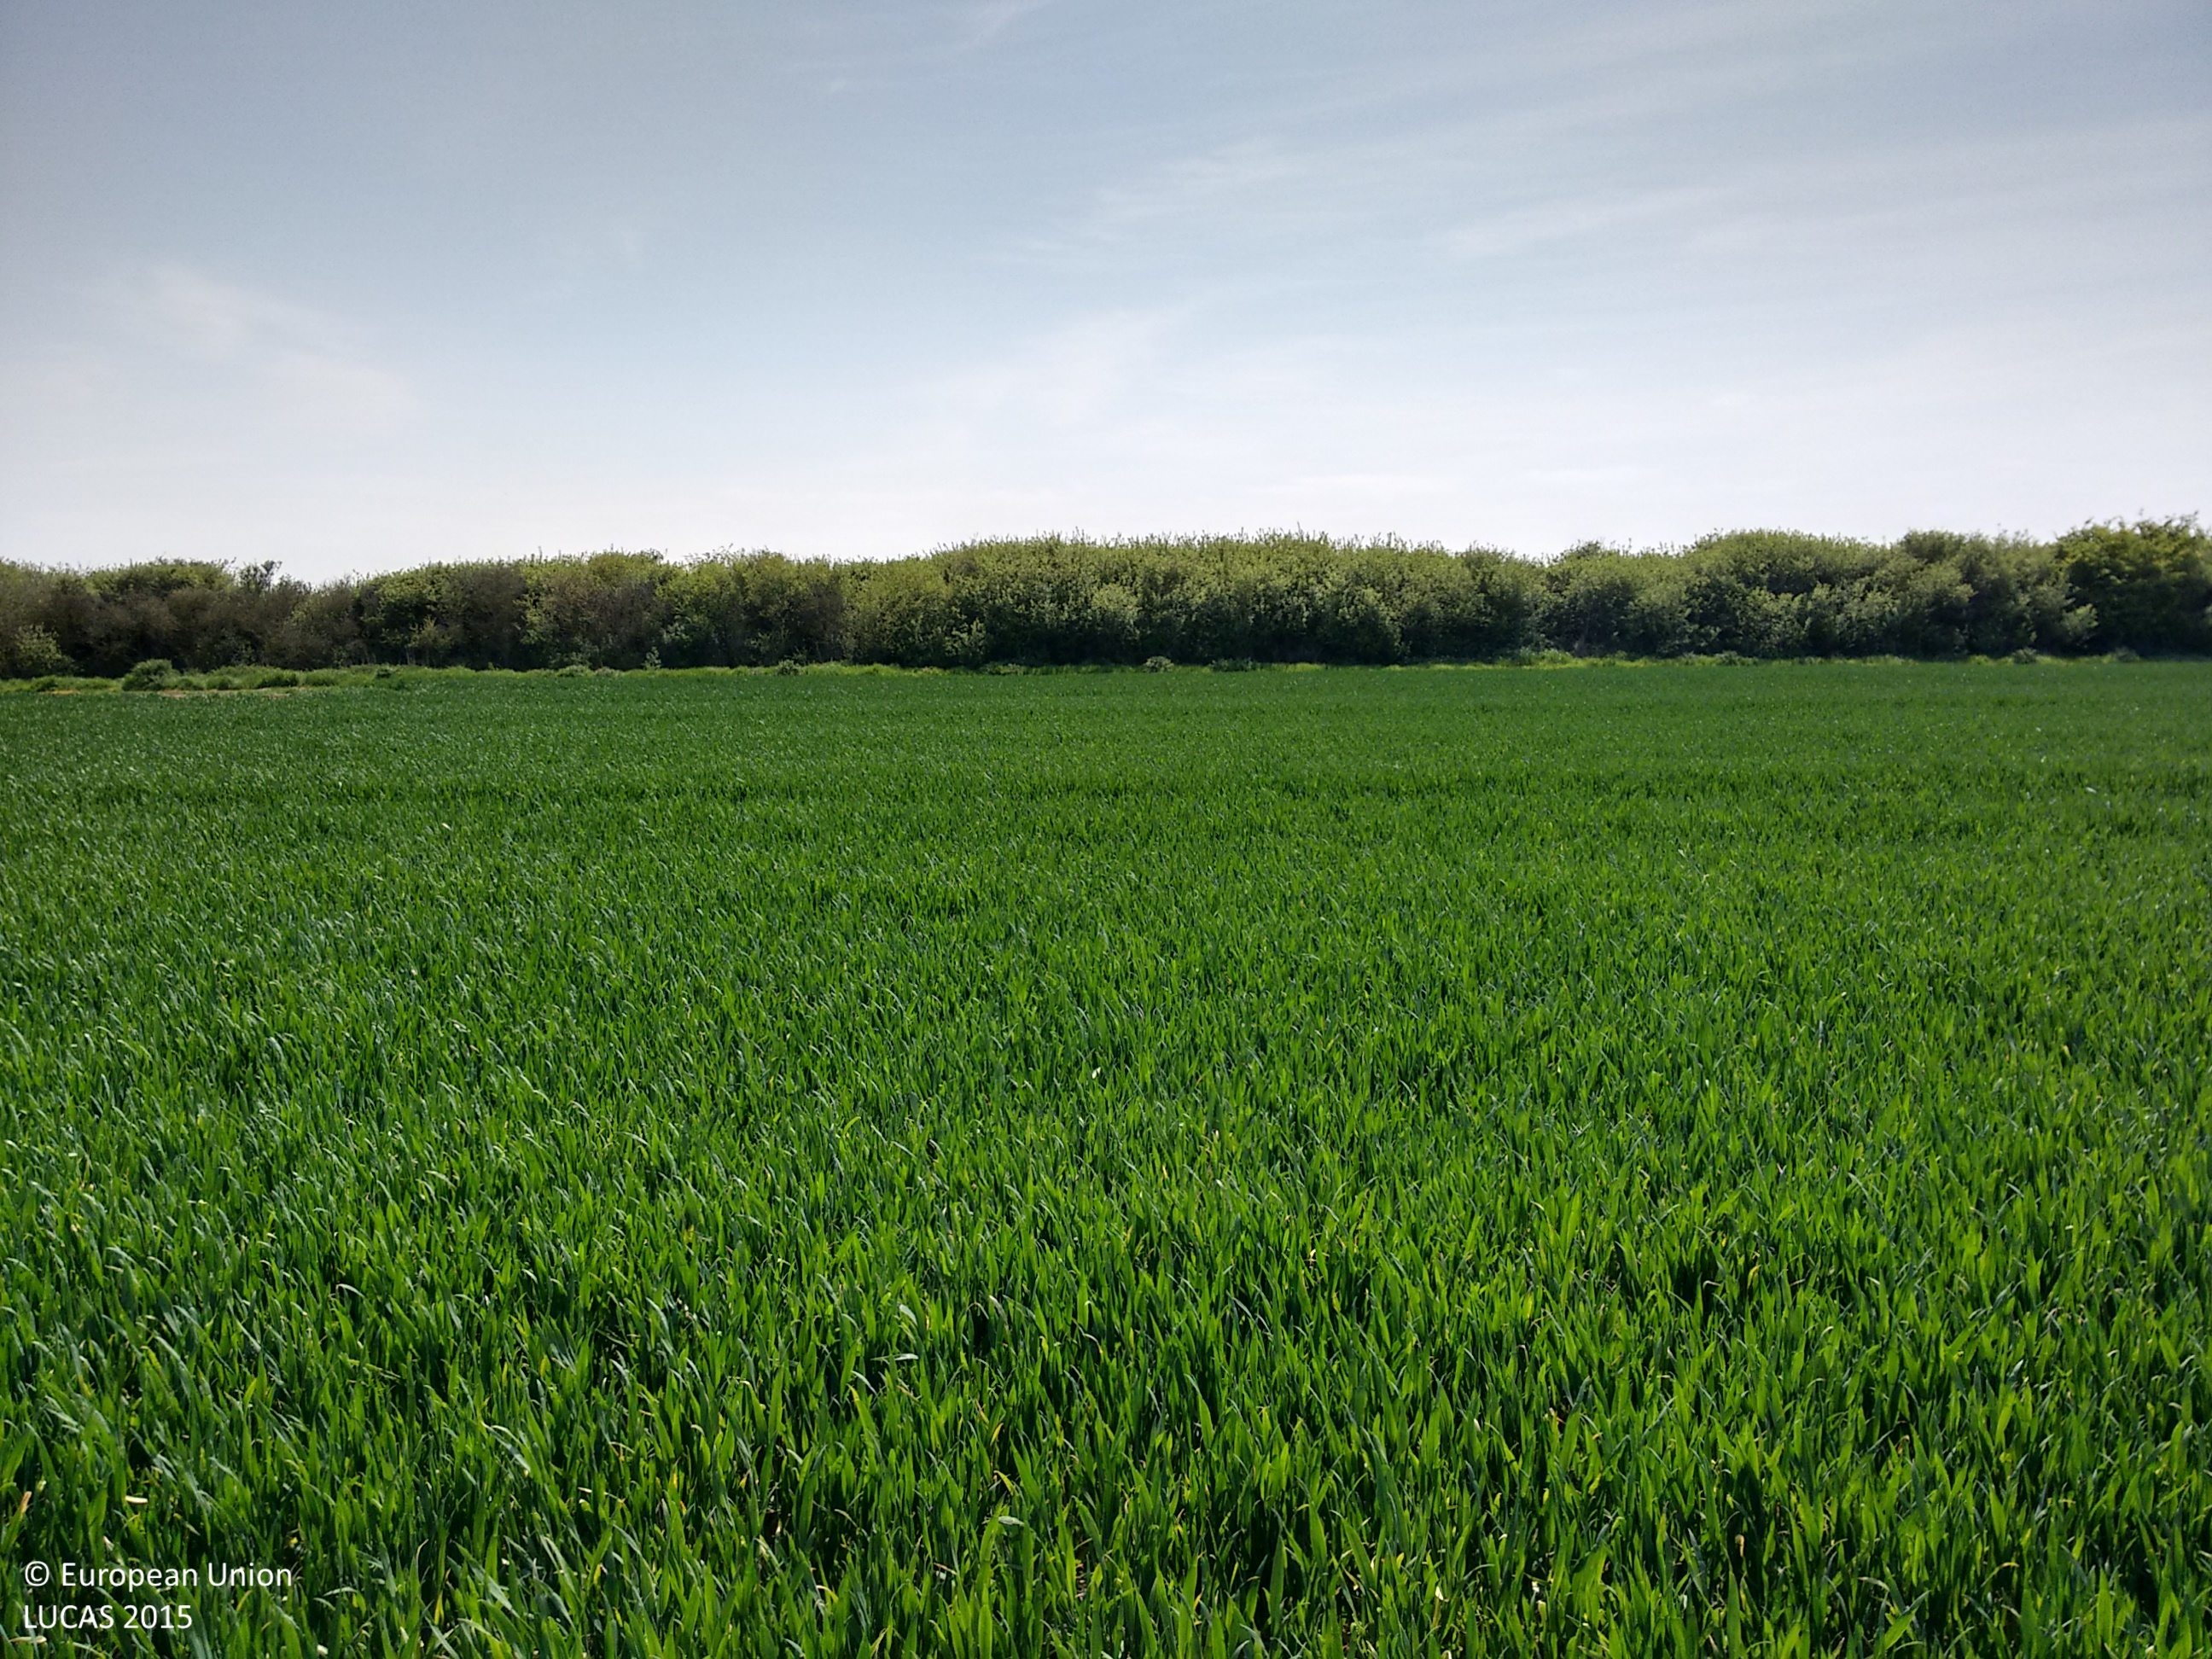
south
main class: Cropland
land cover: Common wheat
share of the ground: > 75 %
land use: Agriculture (excluding fallow land and kitchen gardens)
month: May
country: GB
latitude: 53.6646
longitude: 0.0868
